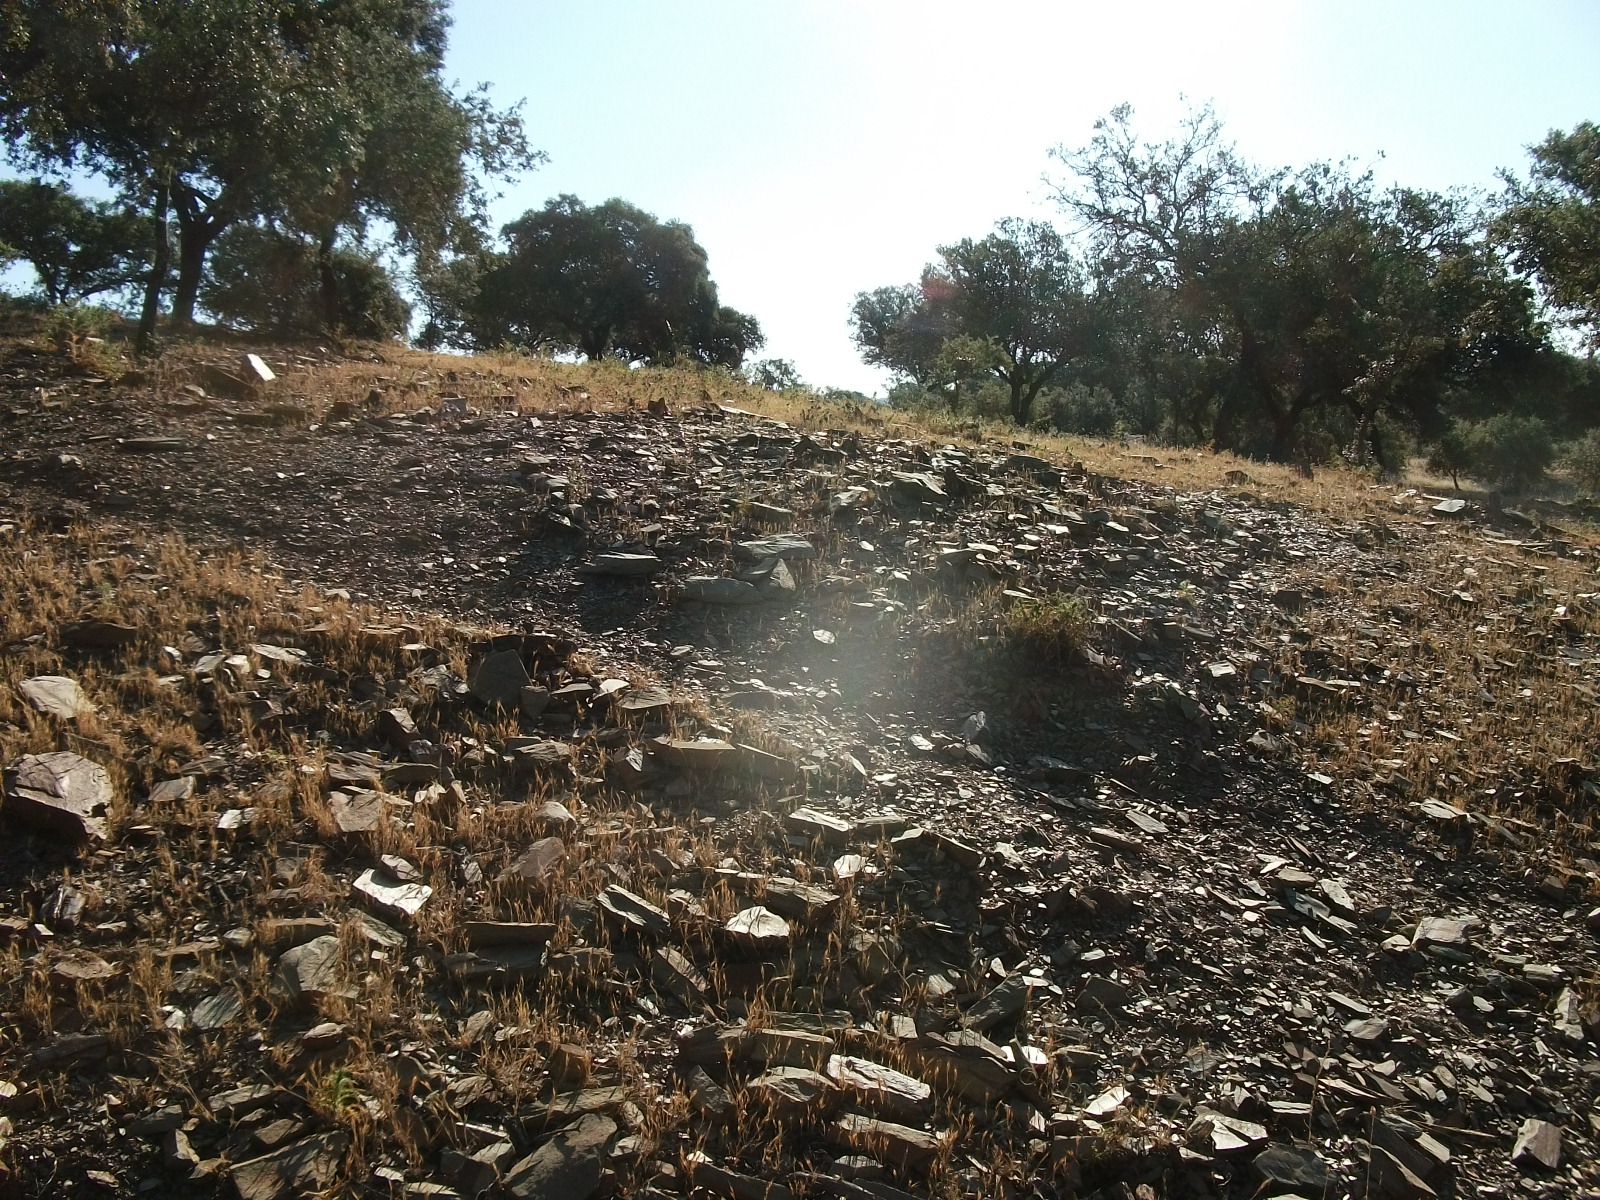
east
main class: Woodland
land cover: Broadleaved woodland
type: broadleaved evergreen forest
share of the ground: 50 - 75 %
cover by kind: broadleaved forest trees 70 %, herbaceous plants 20 %, unconsolidated bare surface 10 %
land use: Agriculture (excluding fallow land and kitchen gardens)
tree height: < 5 m
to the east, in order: Broadleaved woodland; Fences; Grassland without tree/shrub cover; Tracks; Grassland without tree/shrub cover
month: June
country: ES
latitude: 37.6609
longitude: -7.0176
